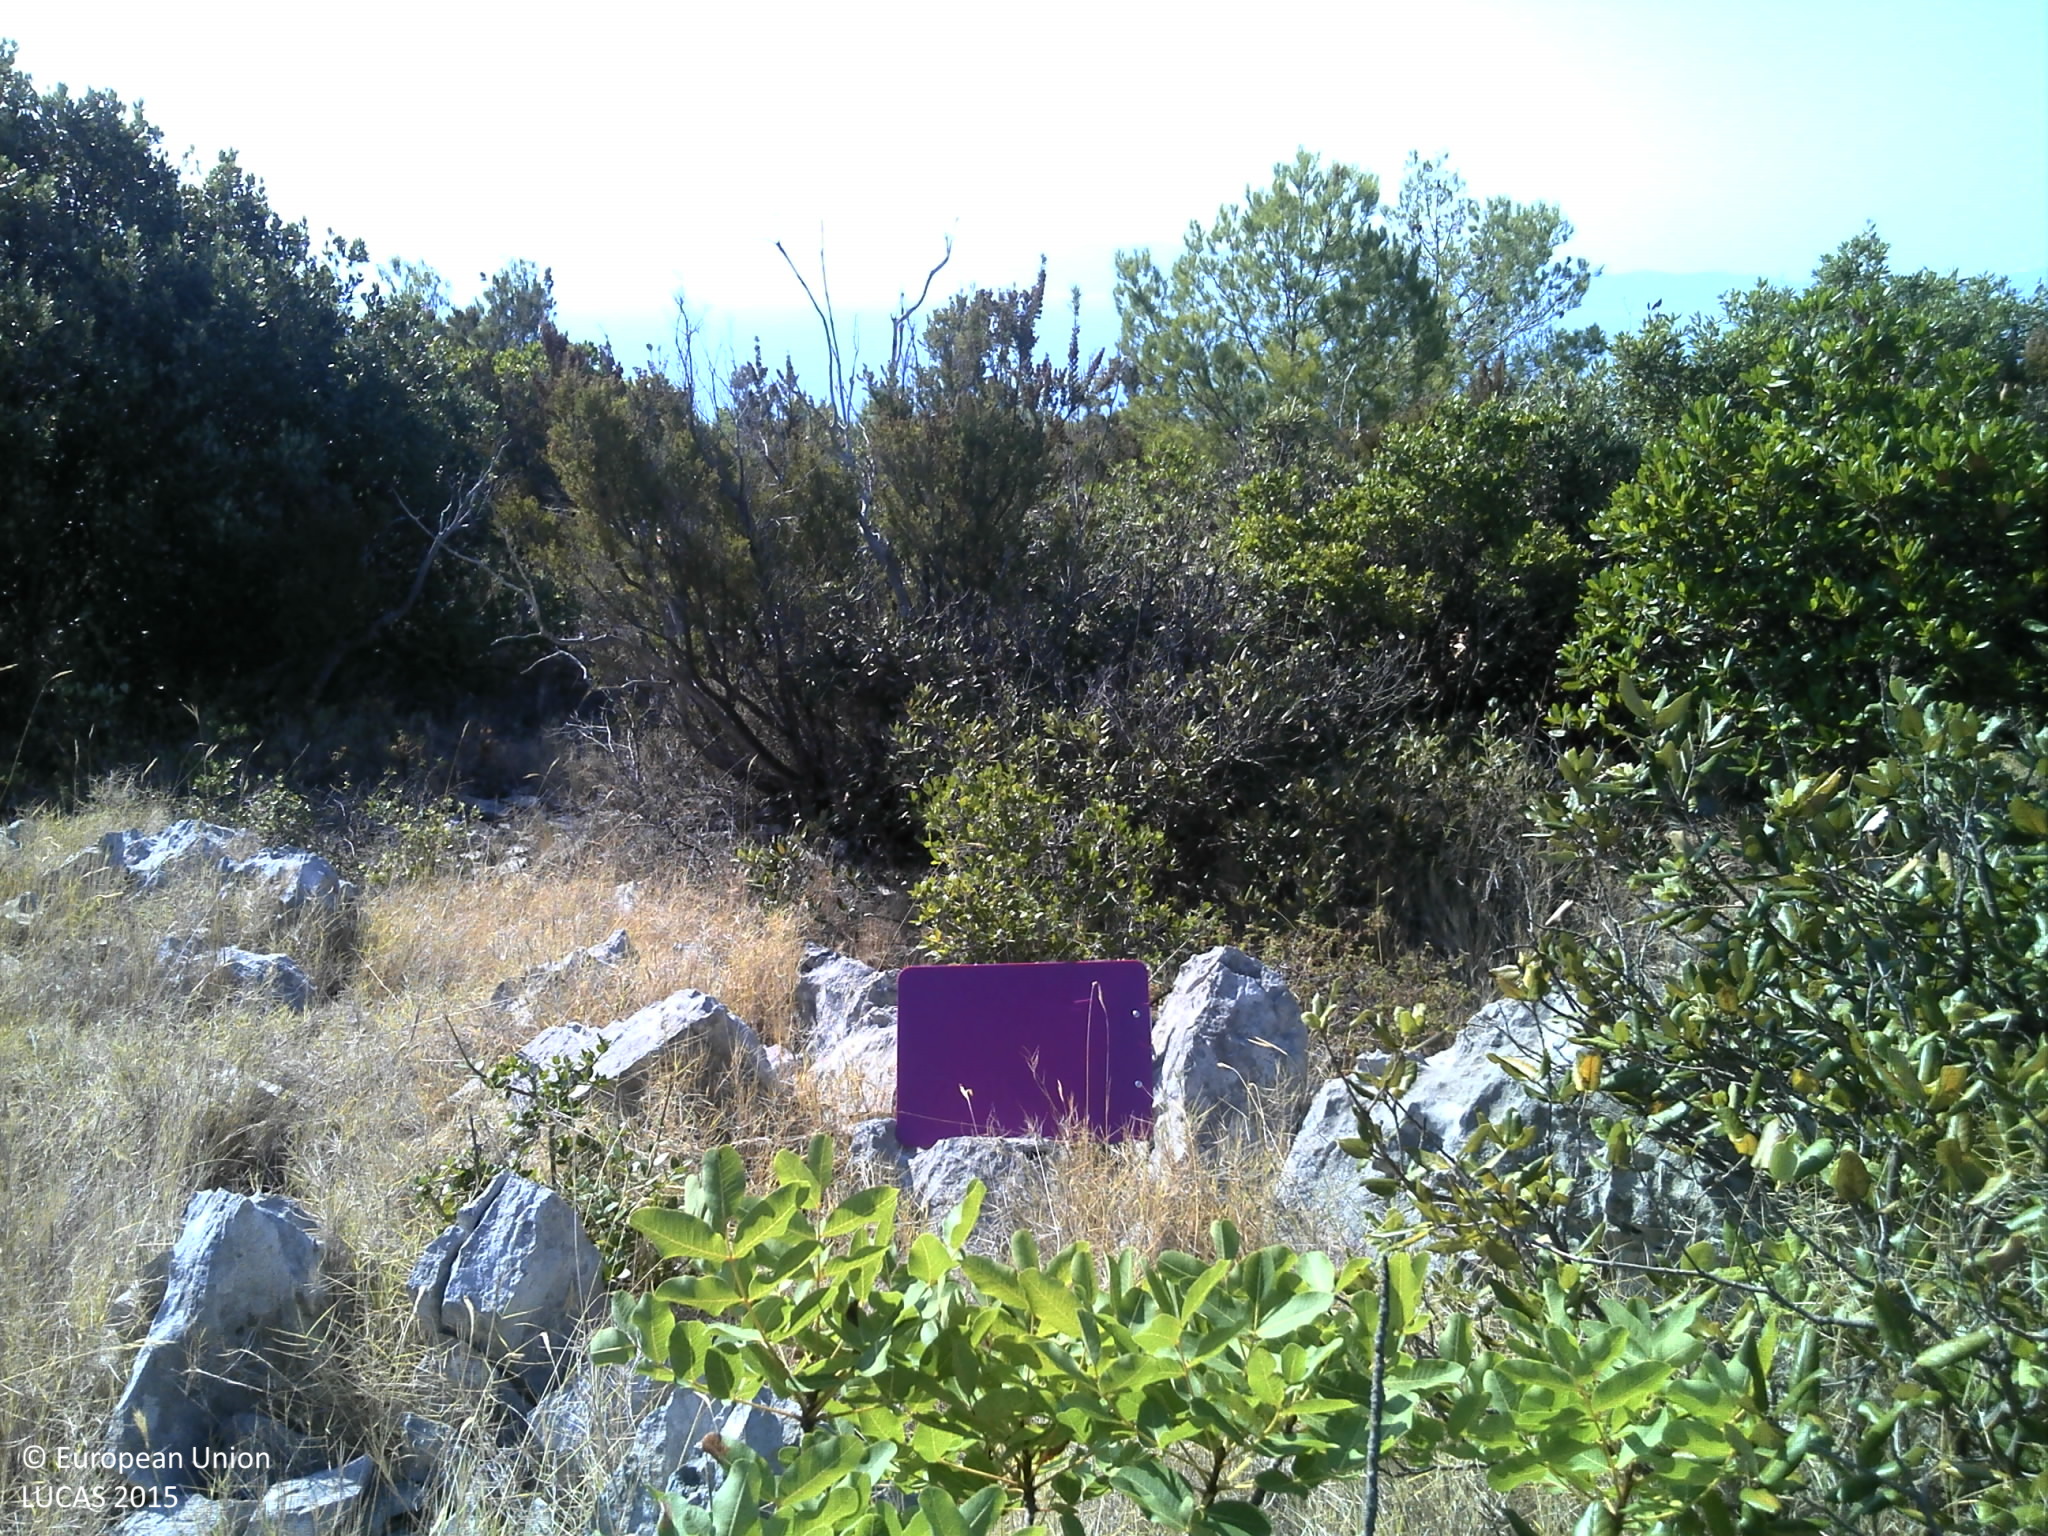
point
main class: Shrubland
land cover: Shrubland with sparse tree cover
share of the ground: > 75 %
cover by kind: shrubs 75 %, herbaceous plants 10 %, broadleaved forest trees 5 %, consolidated bare surface 5 %, unconsolidated bare surface 5 %
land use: Semi-natural and natural areas not in use
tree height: < 5 m
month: August
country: HR
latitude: 43.1277
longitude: 16.8611
